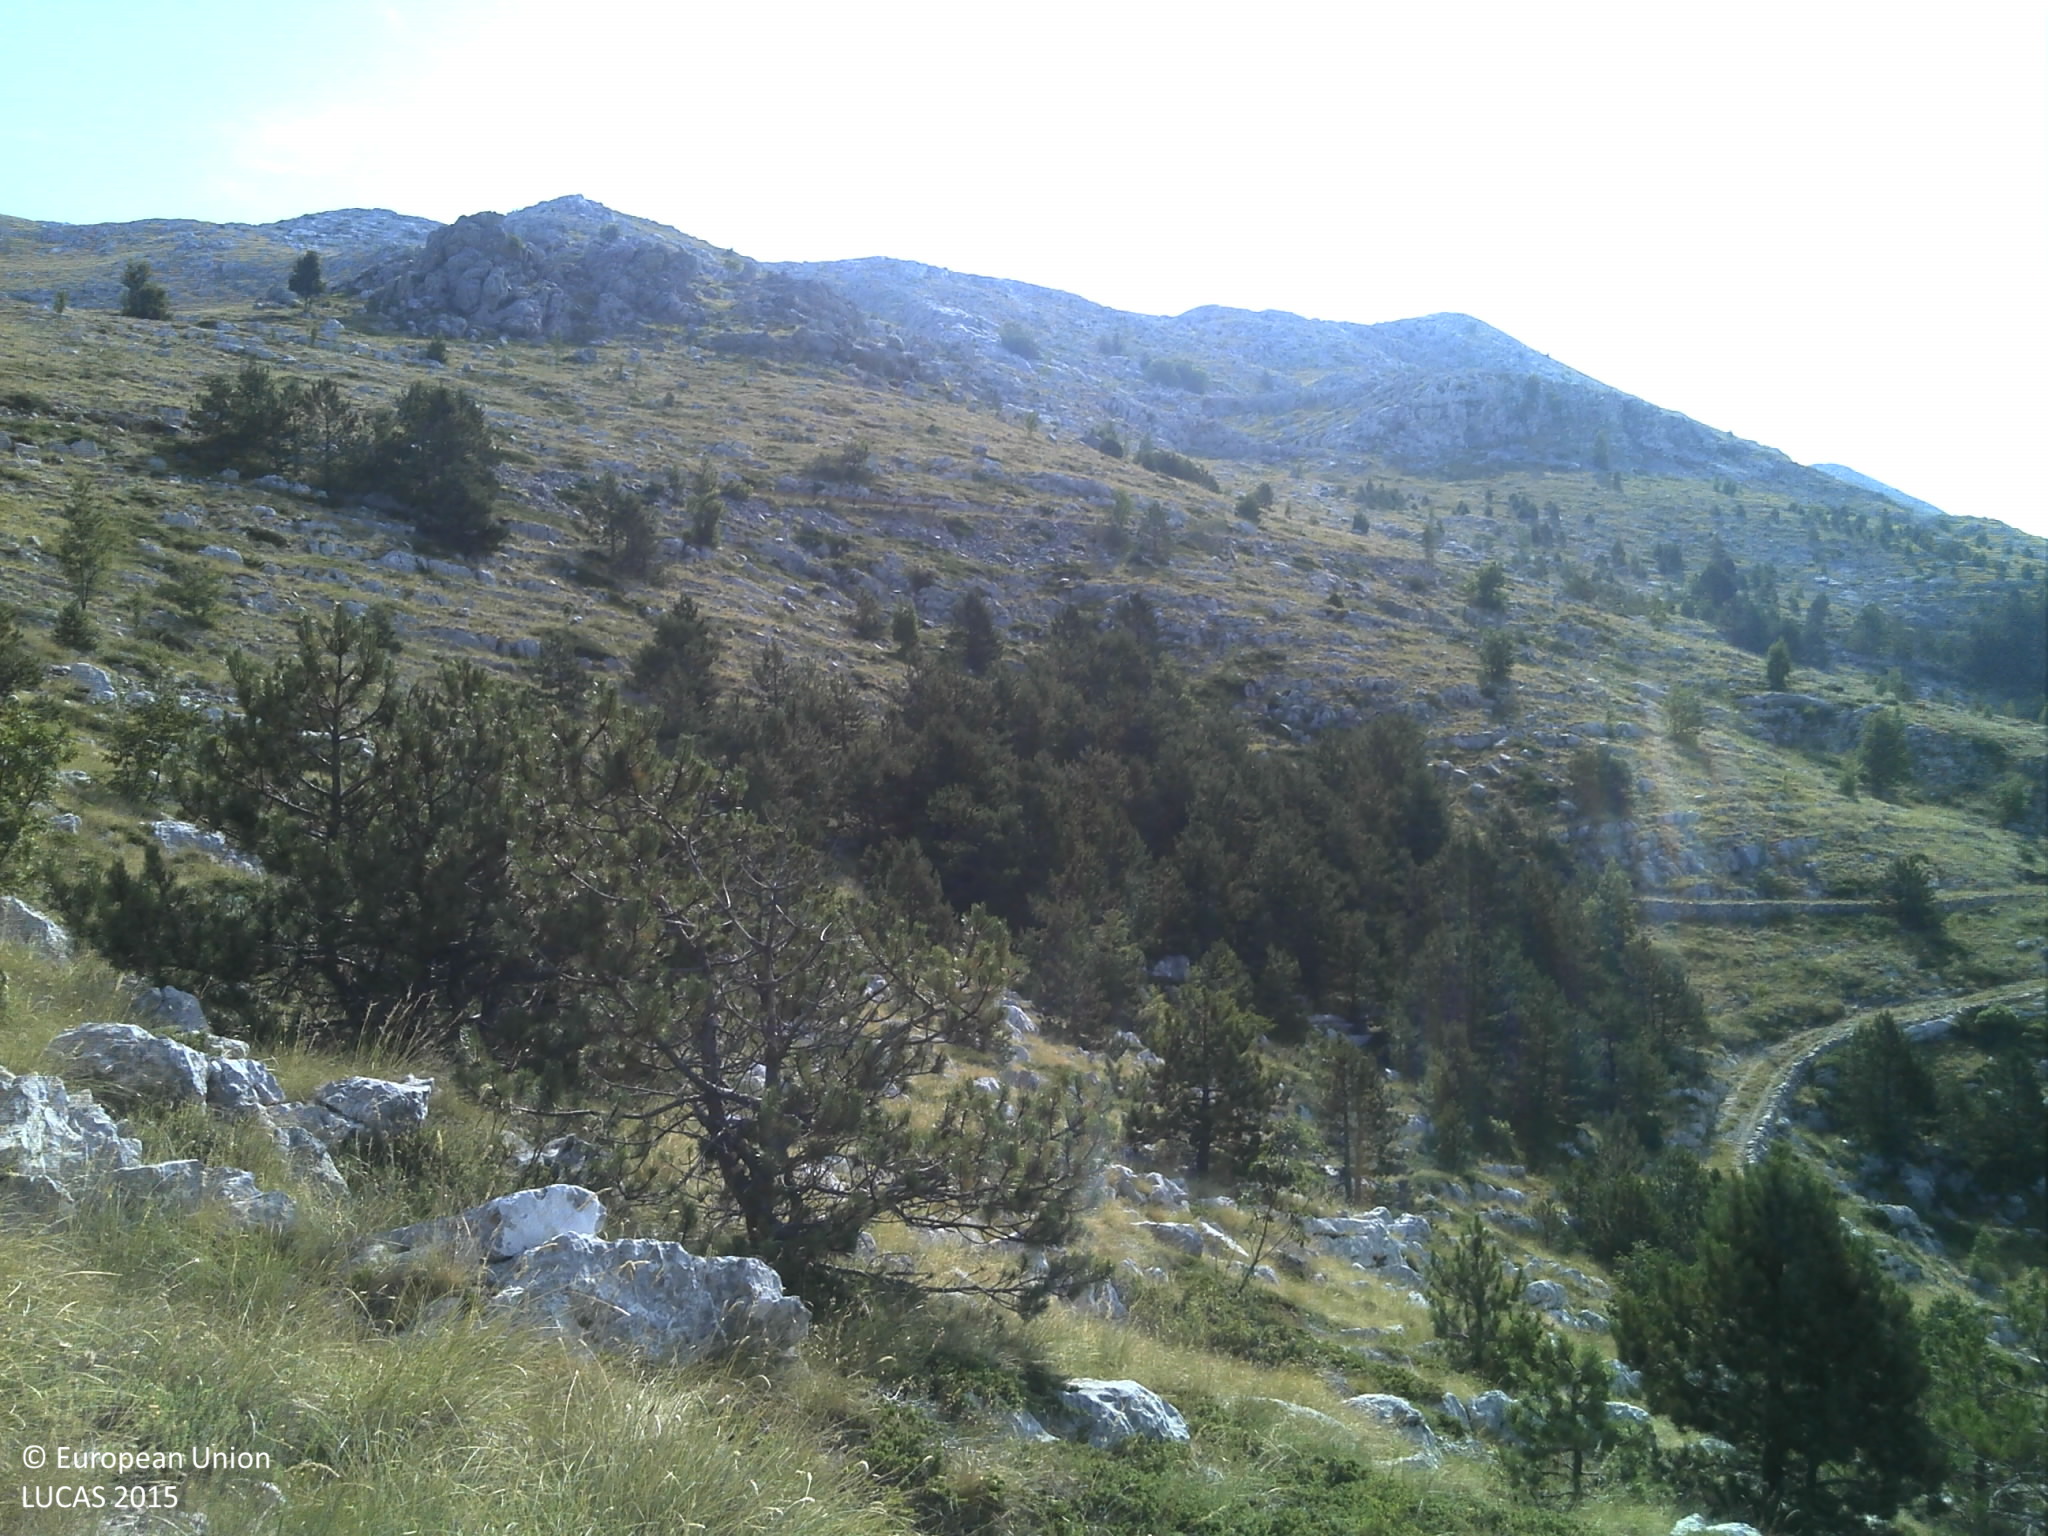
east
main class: Woodland
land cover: Pine dominated coniferous woodland
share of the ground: 10 - 25 %
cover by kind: herbaceous plants 60 %, coniferous forest trees 15 %, shrubs 10 %, unconsolidated bare surface 10 %, consolidated bare surface 5 %
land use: Semi-natural and natural areas not in use
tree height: > 5 m
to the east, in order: Pine dominated coniferous woodland; Tracks; Grassland with sparse tree/shrub cover; Pine dominated coniferous woodland; Tracks; Pine dominated coniferous woodland; Grassland with sparse tree/shrub cover; Paved roads, cycling and walking lanes; Grassland with sparse tree/shrub cover
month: August
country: HR
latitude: 43.2940
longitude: 17.0782
